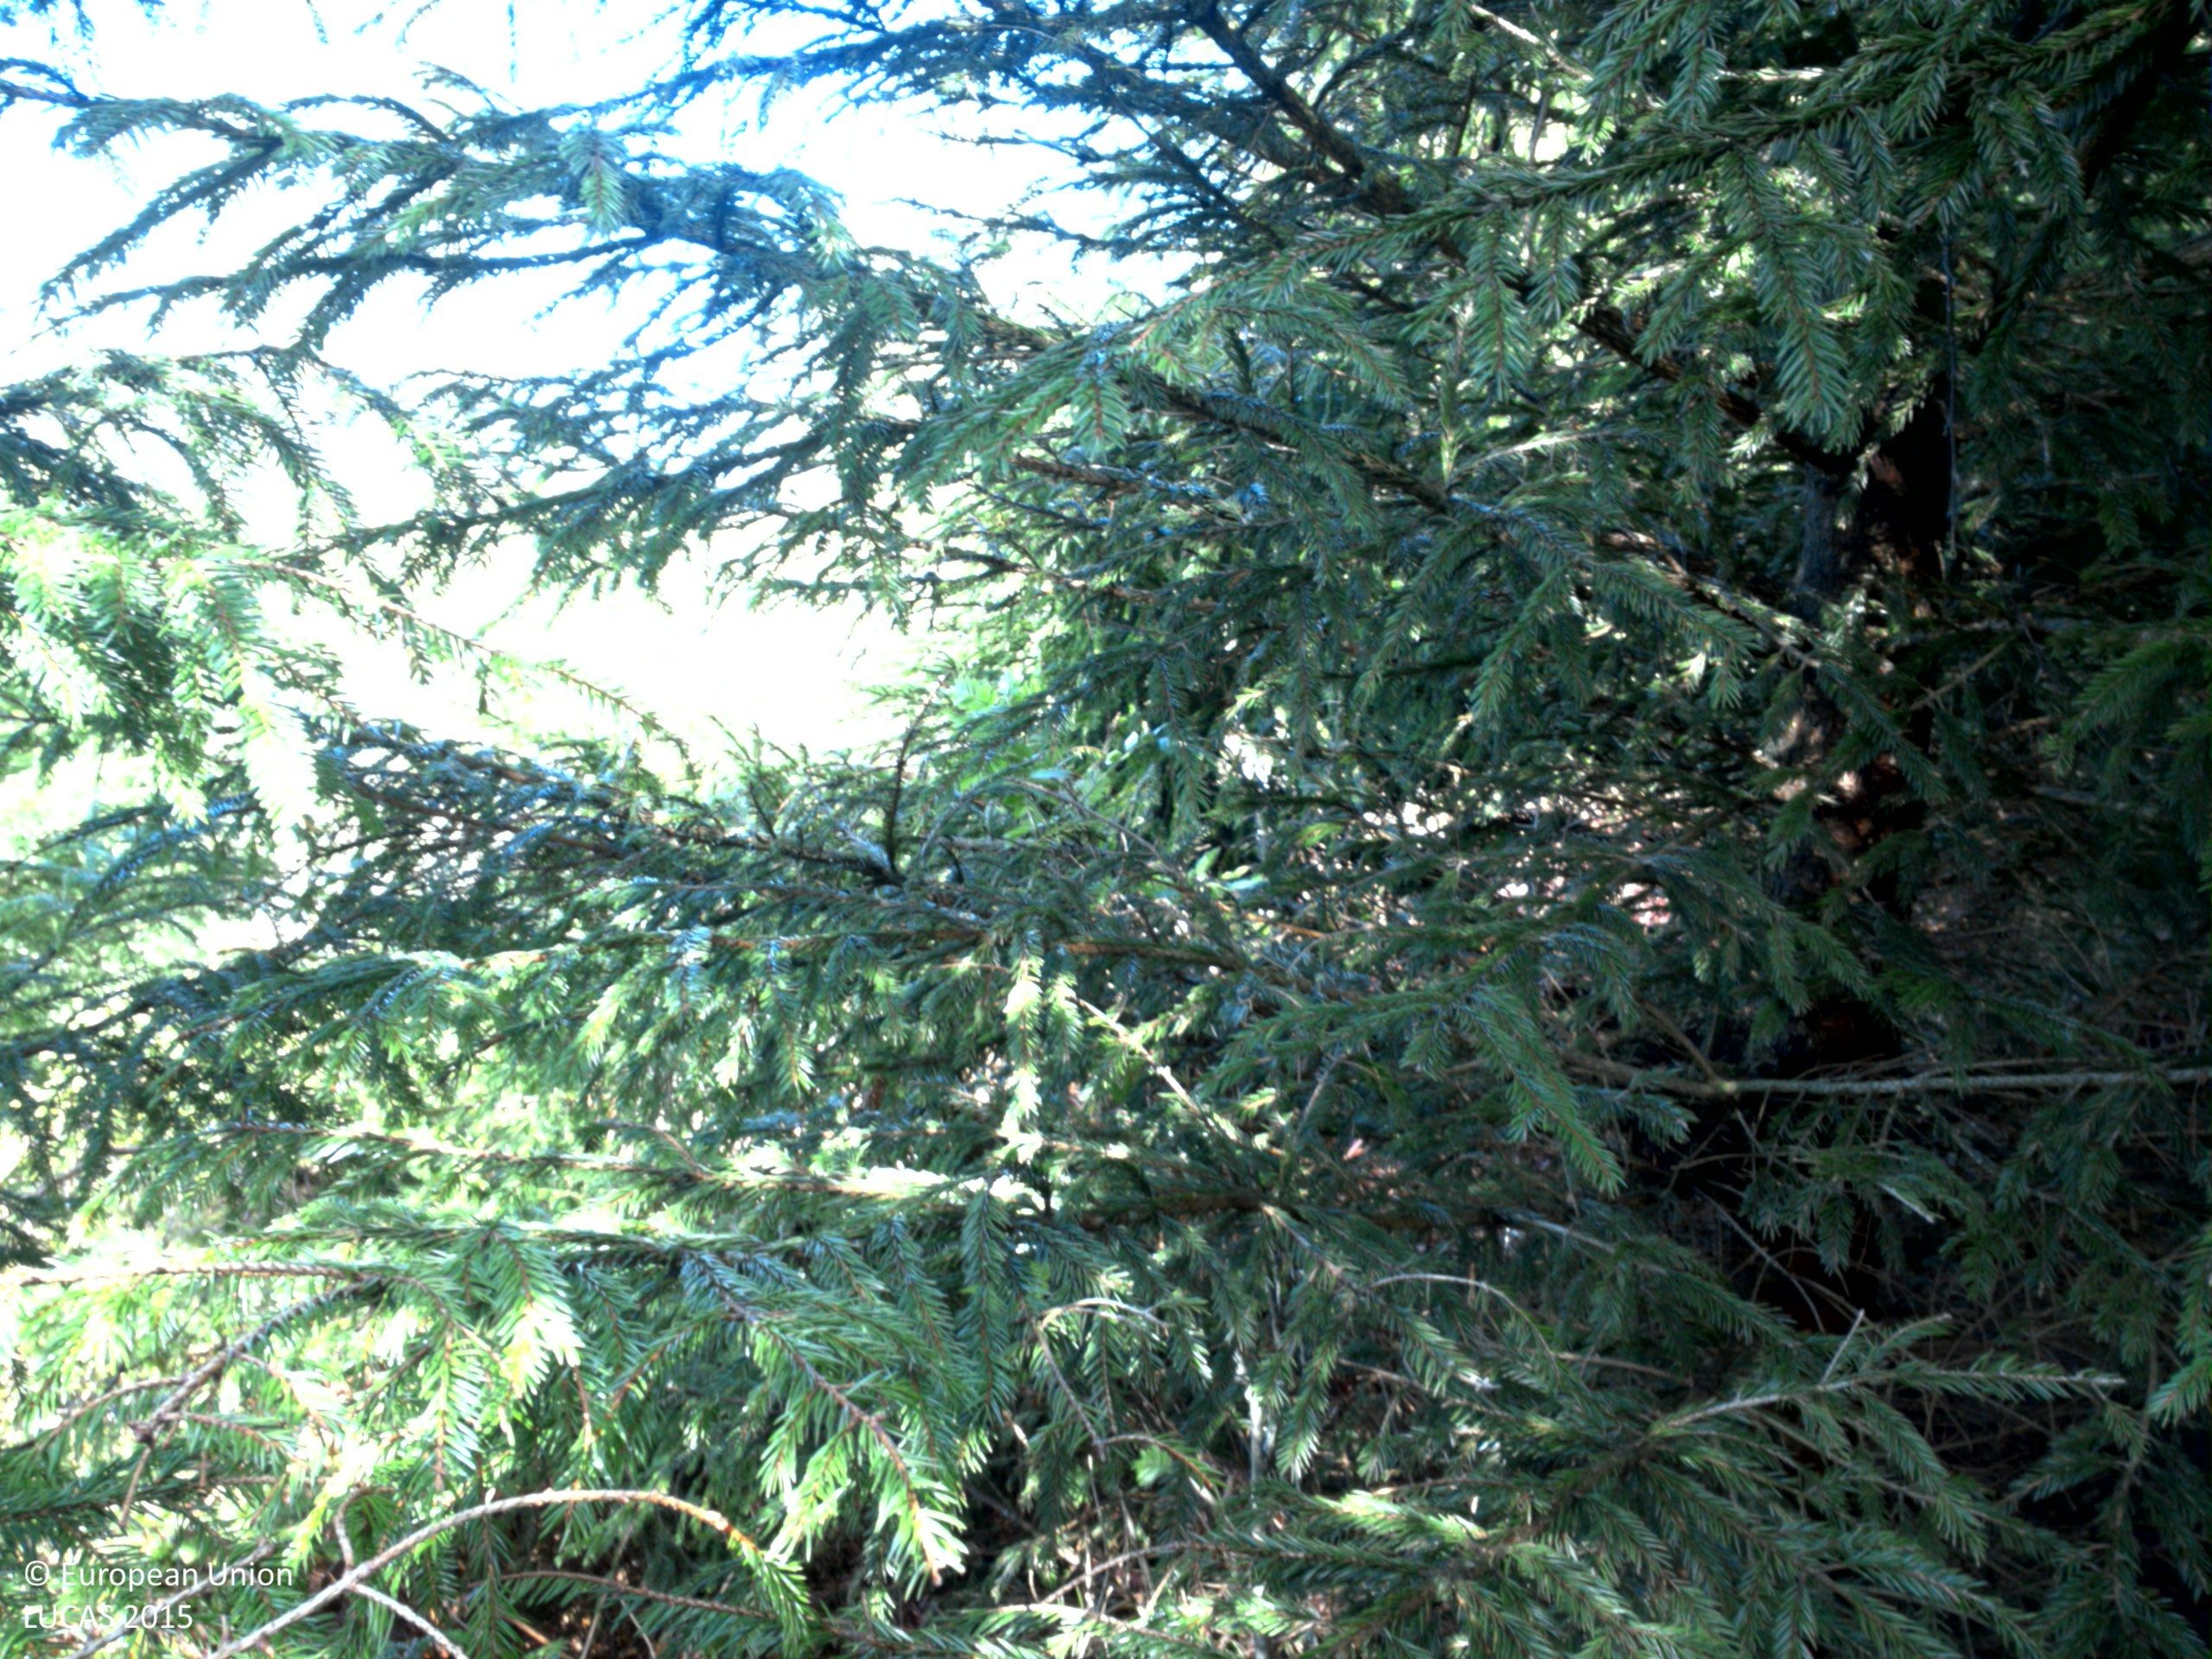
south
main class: Woodland
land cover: Spruce dominated coniferous woodland
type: boreal forest
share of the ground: > 75 %
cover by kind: coniferous forest trees 90 %, broadleaved forest trees 5 %, lichens and mosses 5 %
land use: Forestry
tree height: > 5 m
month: May
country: SE
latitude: 57.6814
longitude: 13.0310
